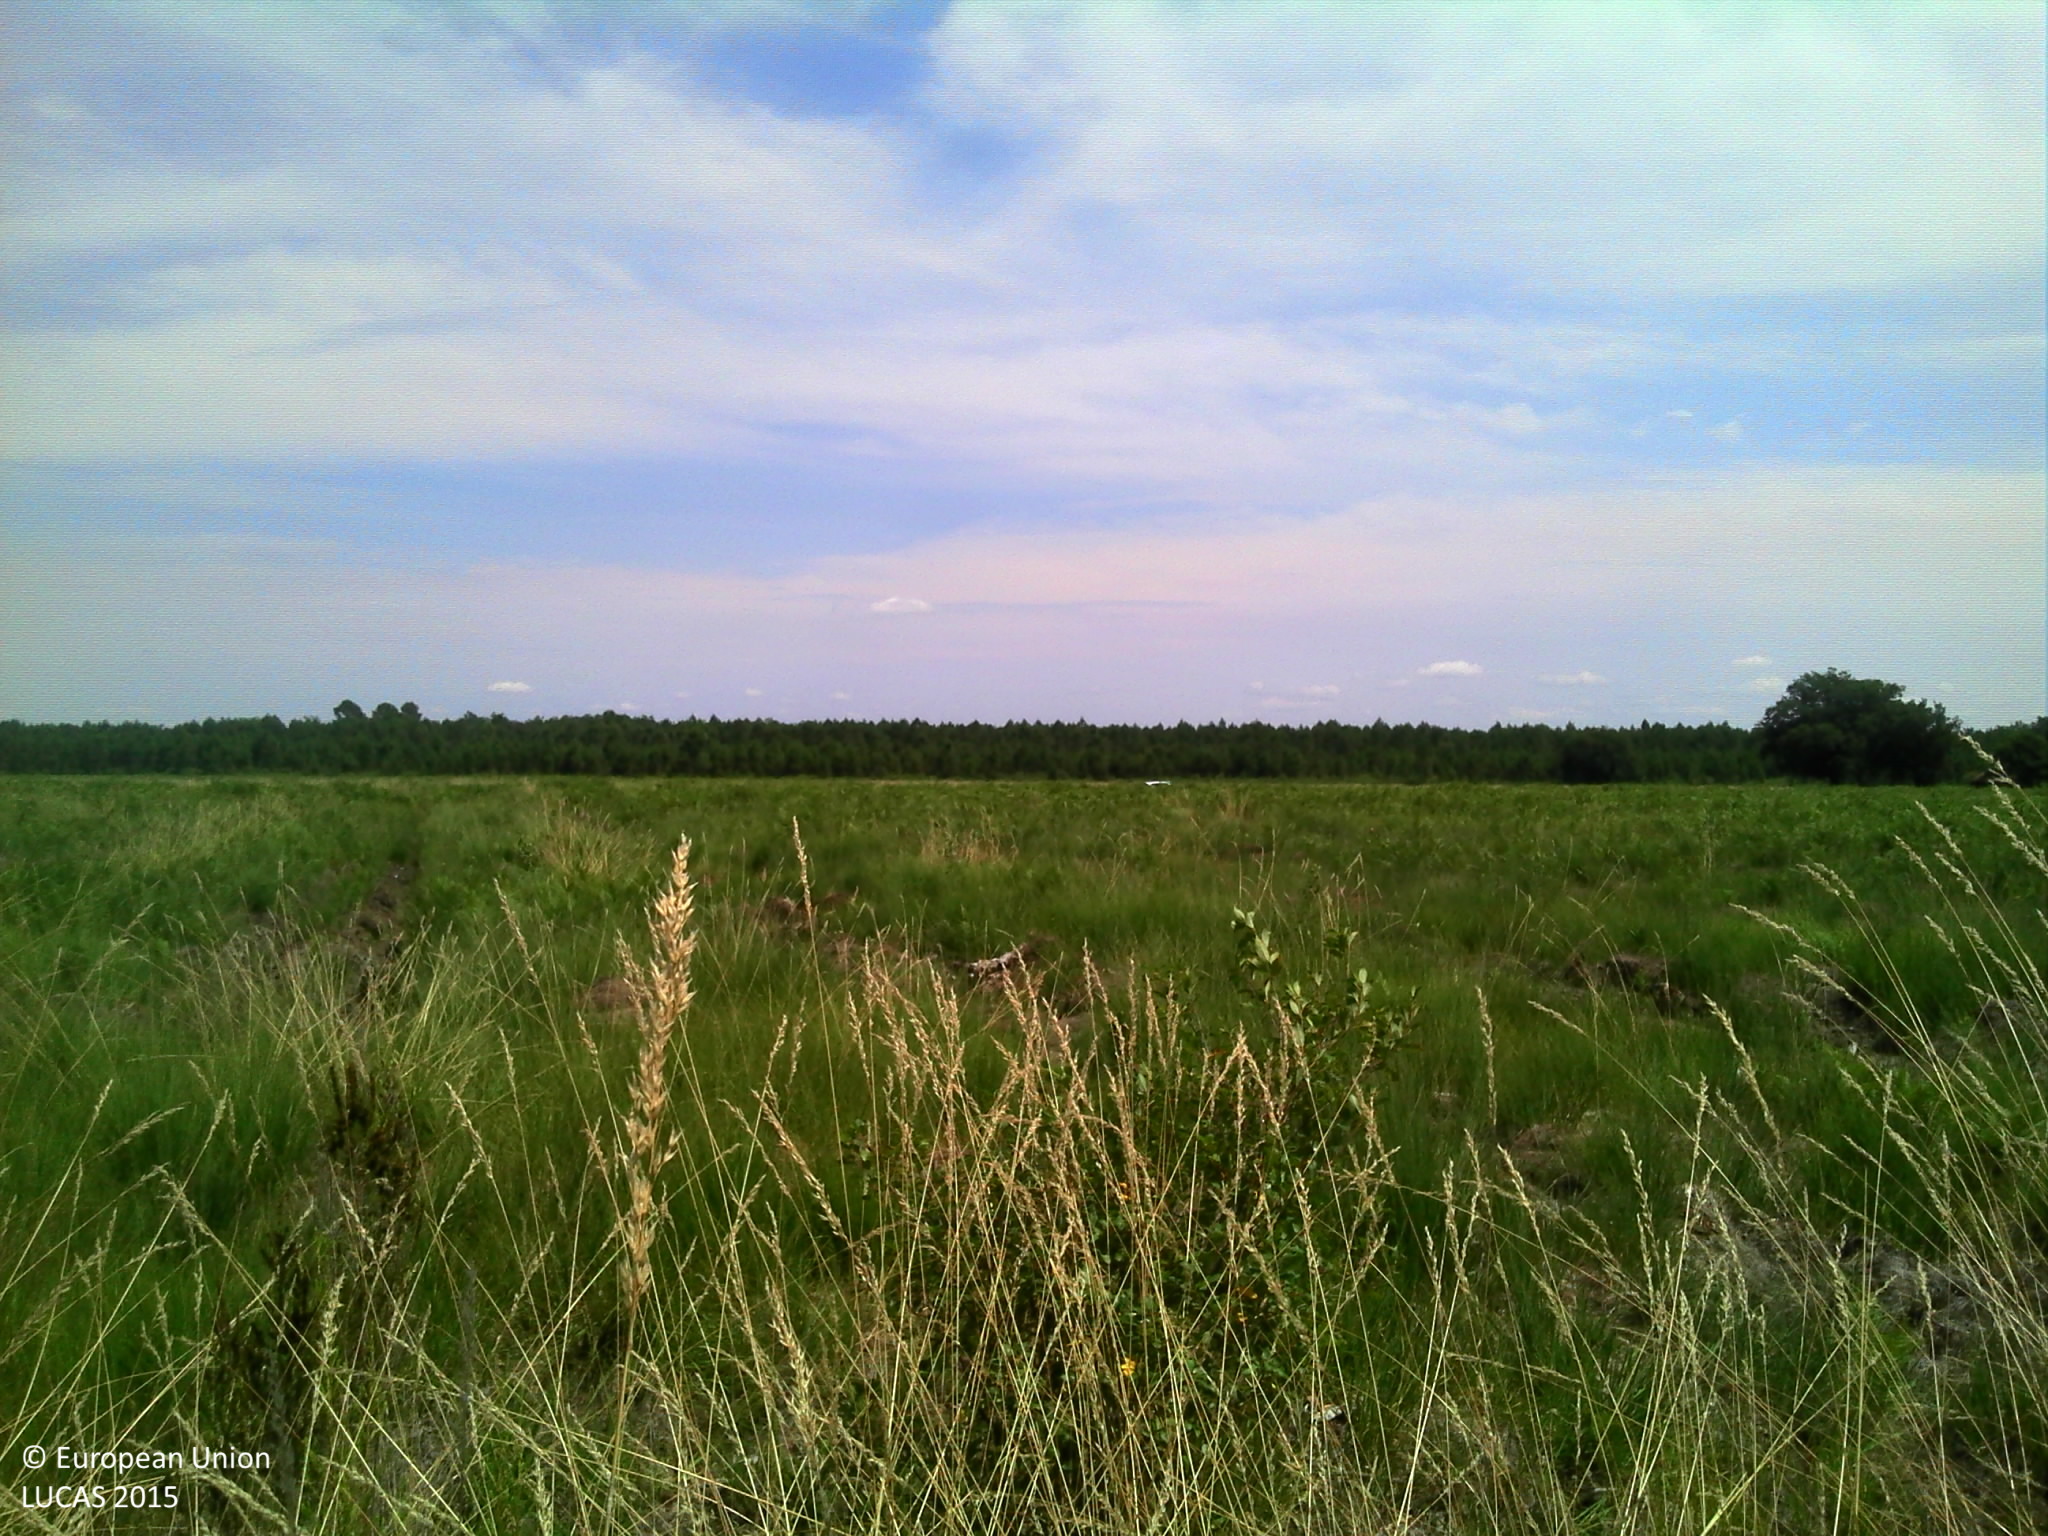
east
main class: Woodland
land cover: Pine dominated coniferous woodland
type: coniferous forest of the mediterranean region
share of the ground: > 75 %
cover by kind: coniferous forest trees 70 %, herbaceous plants 30 %
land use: Forestry
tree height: > 5 m
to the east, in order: Pine dominated coniferous woodland; Ditches and canals; Spontaneously vegetated surfaces; Tracks; Grass margins; Rivers and streams; Spontaneously vegetated surfaces
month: July
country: FR
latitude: 44.2300
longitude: -0.5432
